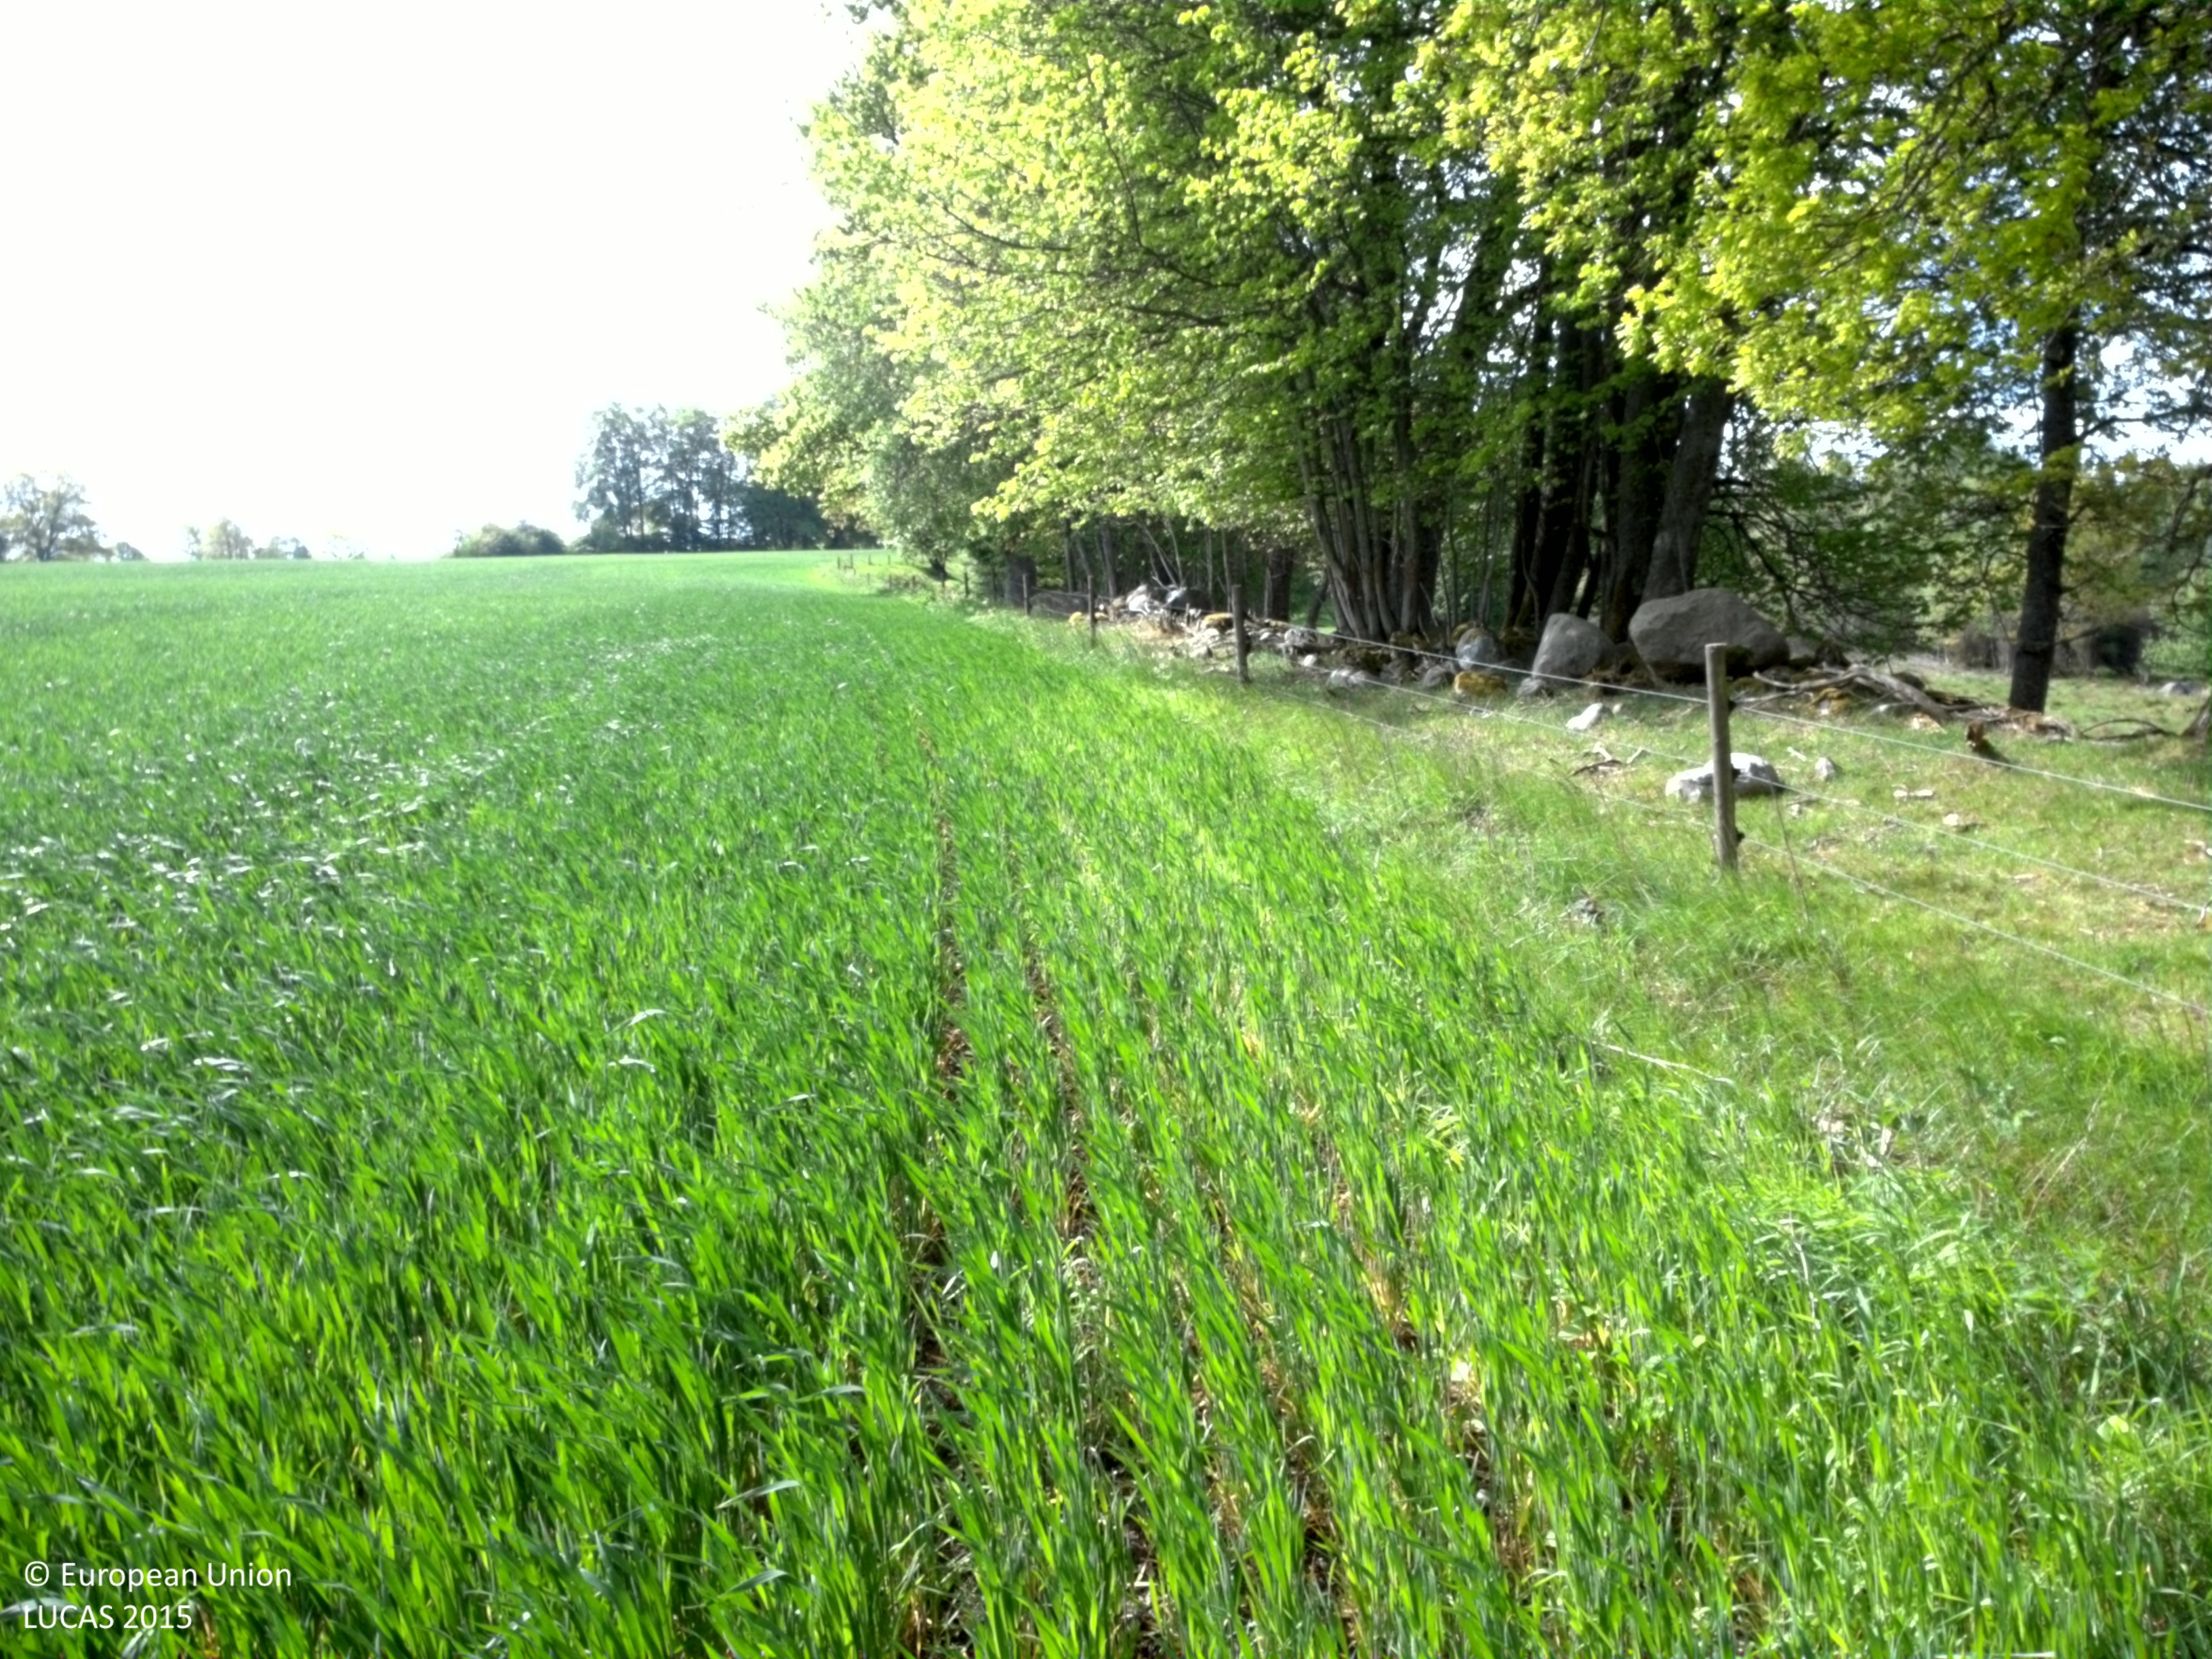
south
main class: Cropland
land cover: Barley
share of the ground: > 75 %
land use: Agriculture (excluding fallow land and kitchen gardens)
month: June
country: SE
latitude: 56.7731
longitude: 14.5624
